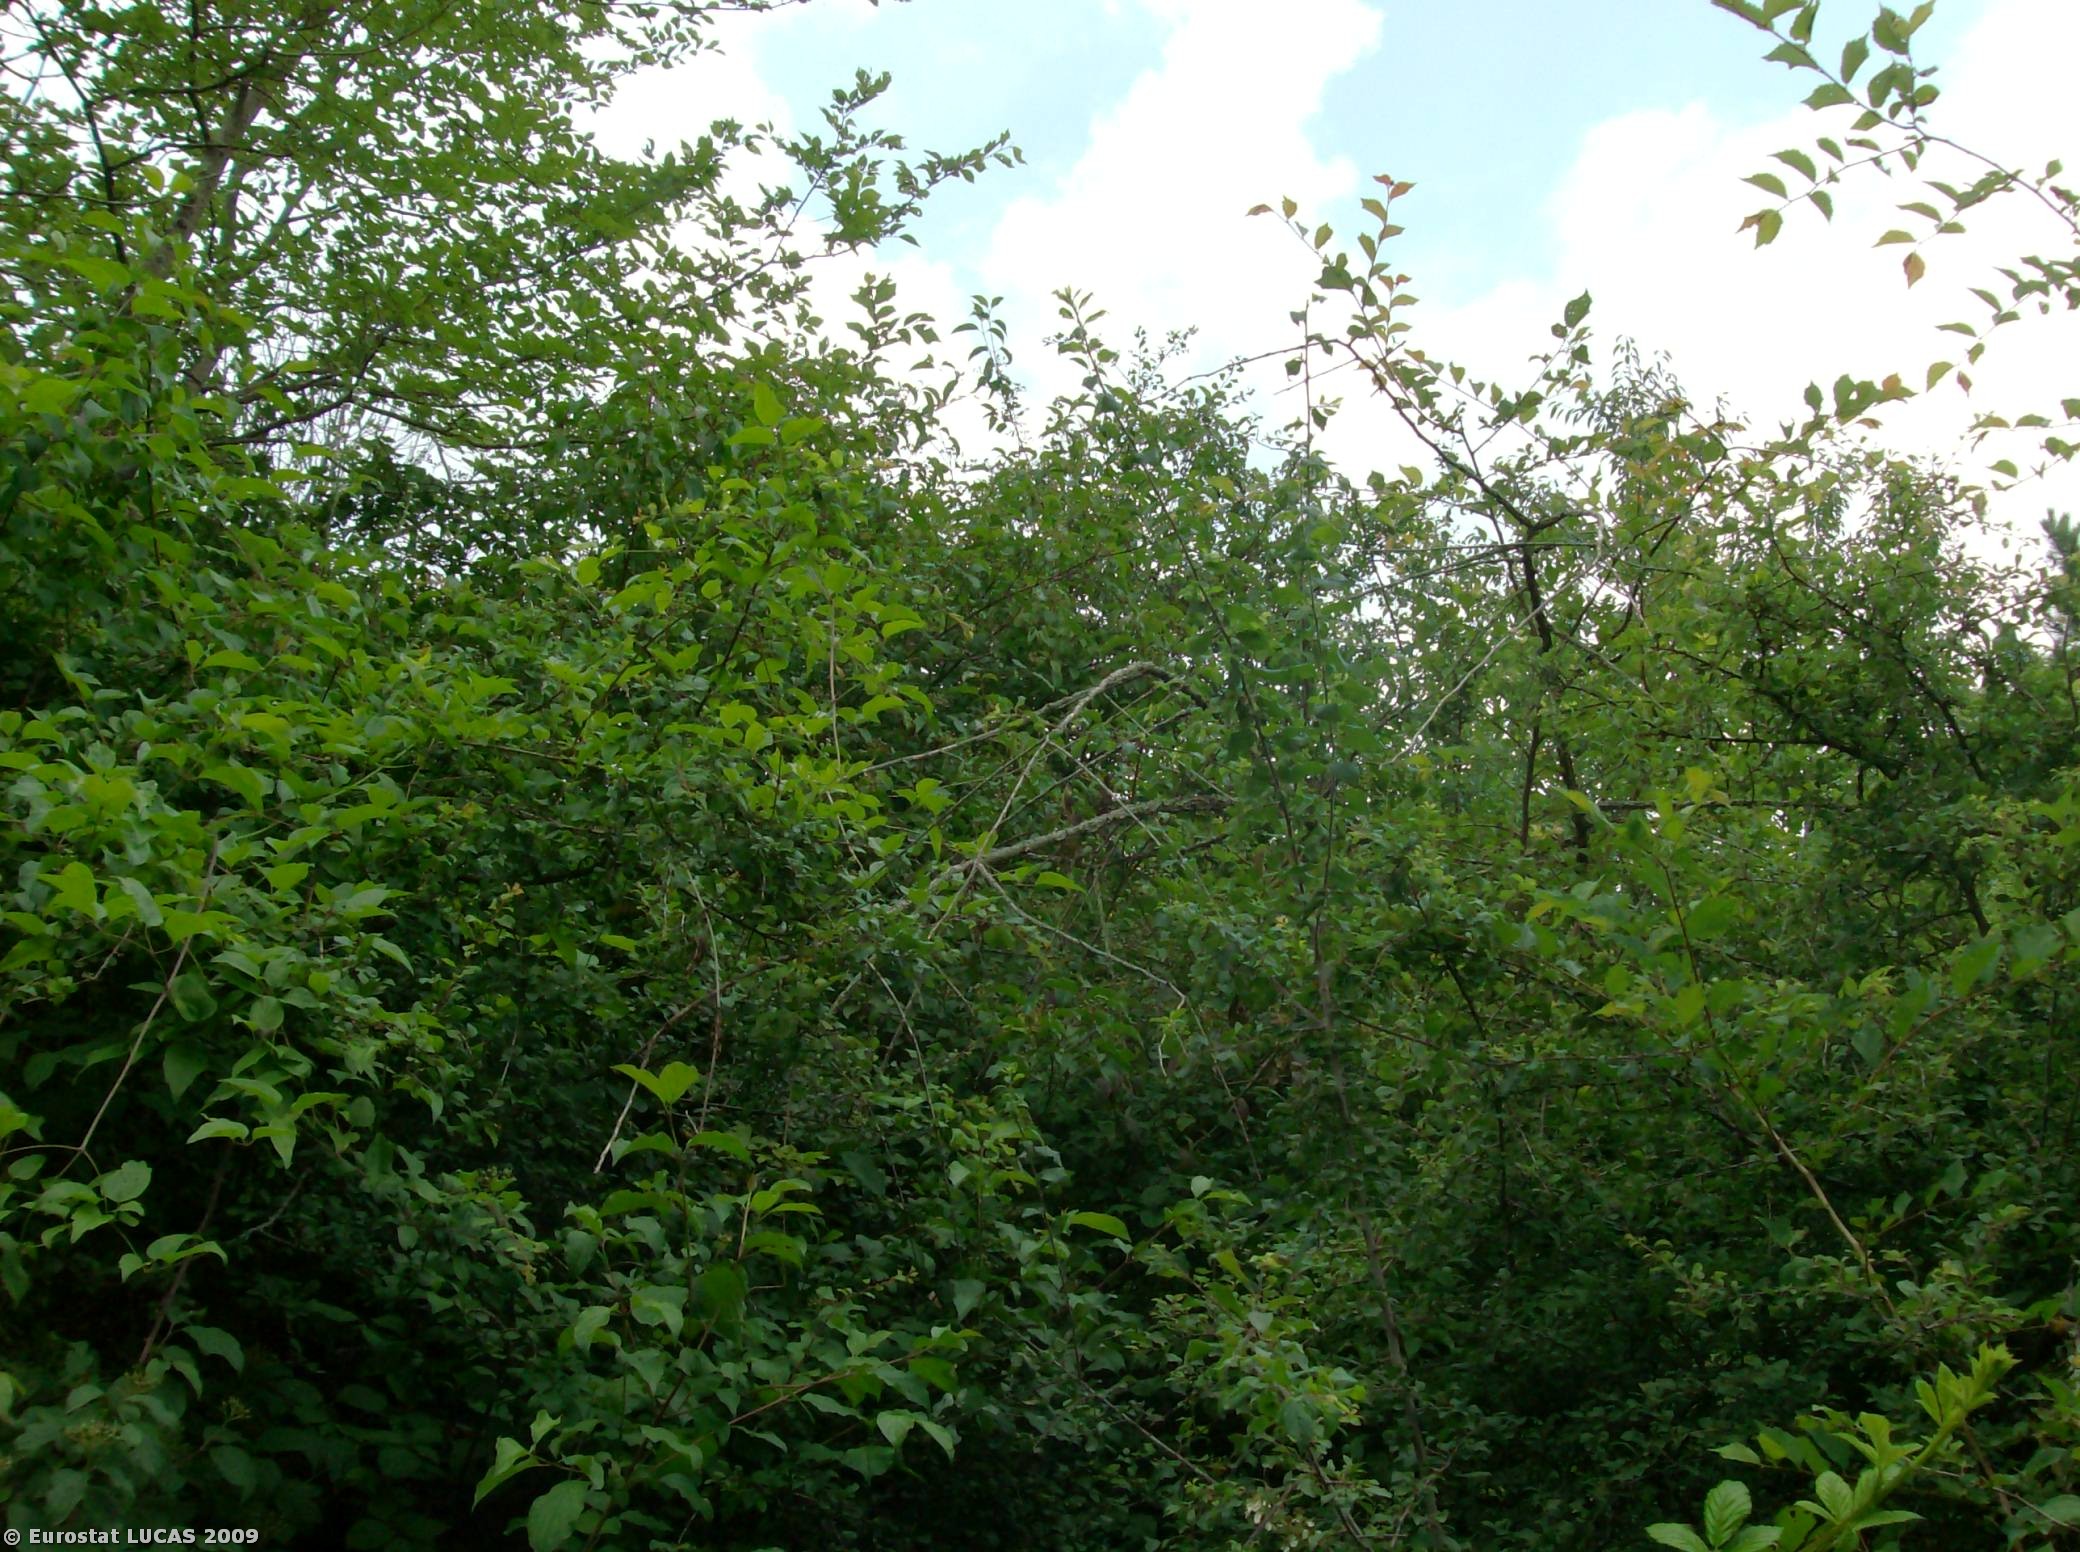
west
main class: Woodland
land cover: Broadleaved woodland
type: thermophilous deciduous forest
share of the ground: > 75 %
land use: Unused
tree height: > 5 m
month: June
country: IT
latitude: 42.8931
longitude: 11.6724
